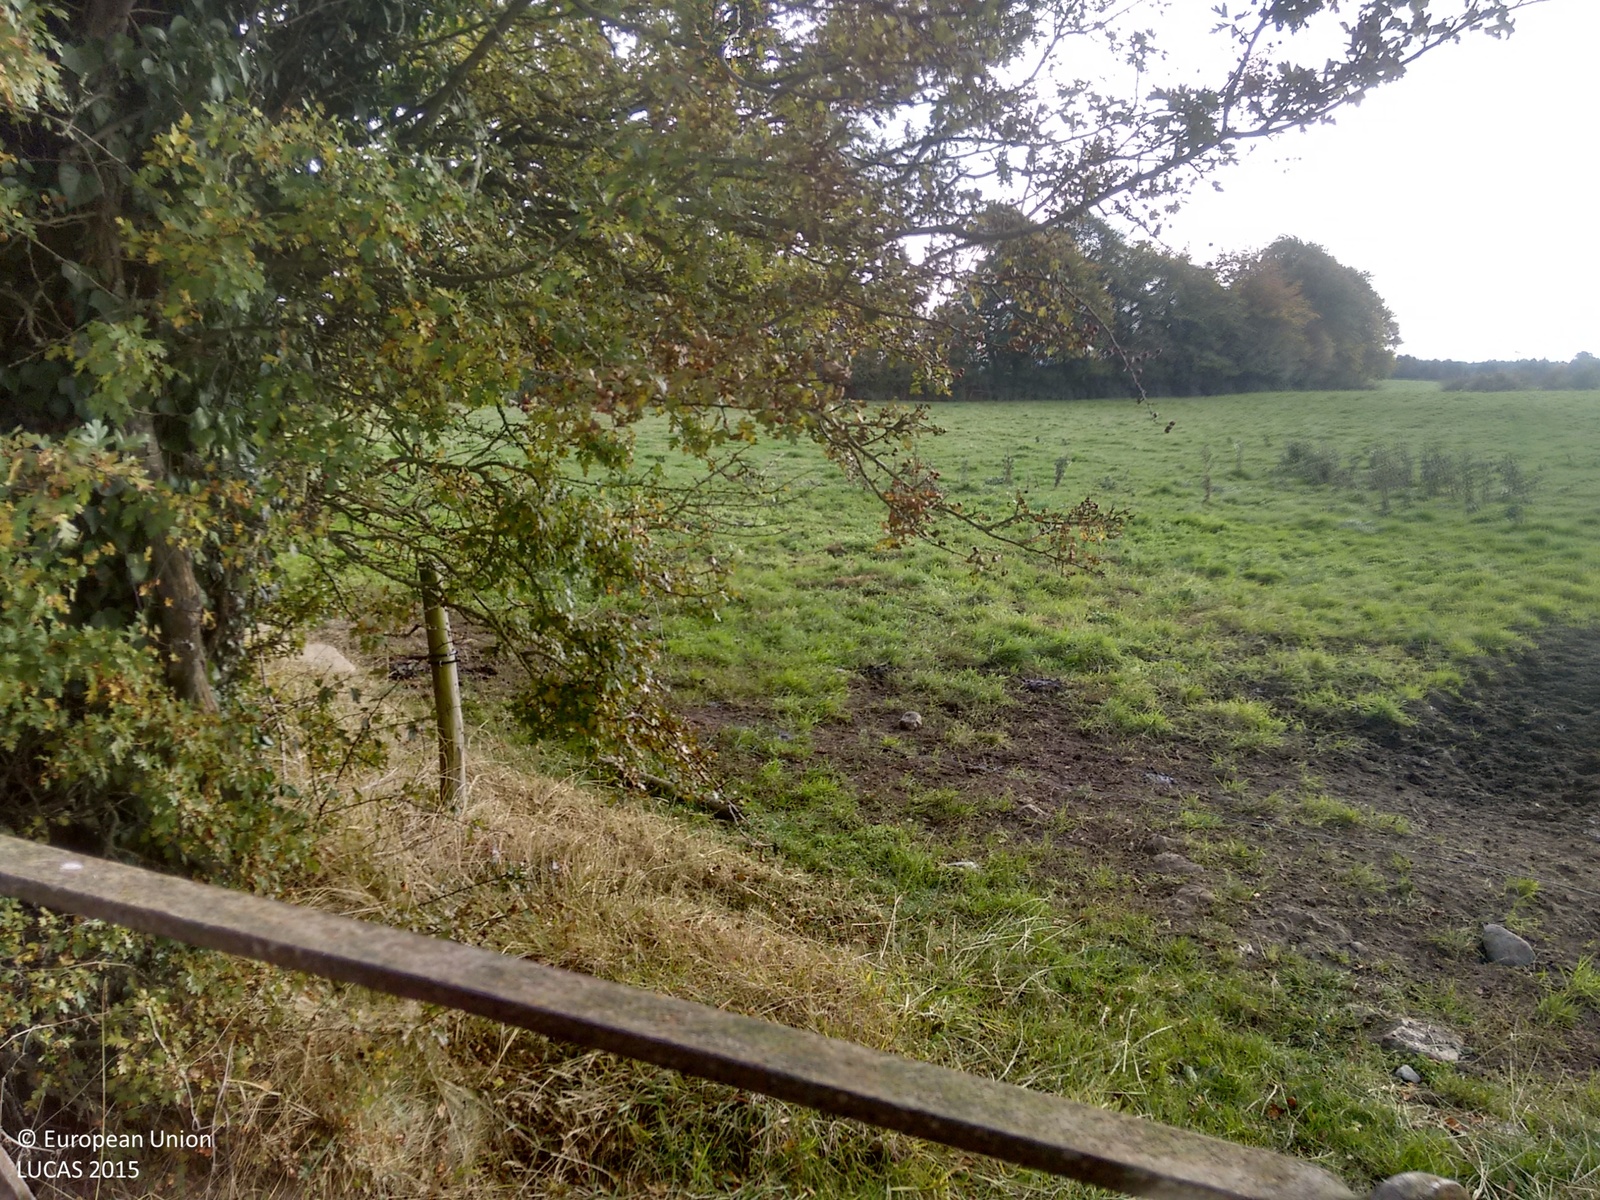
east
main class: Grassland
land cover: Grassland without tree/shrub cover
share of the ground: > 75 %
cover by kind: herbaceous plants 100 %
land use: Agriculture (excluding fallow land and kitchen gardens)
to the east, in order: Grassland without tree/shrub cover; Abandoned hedges; Fences; Grassland without tree/shrub cover
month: October
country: IE
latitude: 52.8343
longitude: -7.6036
